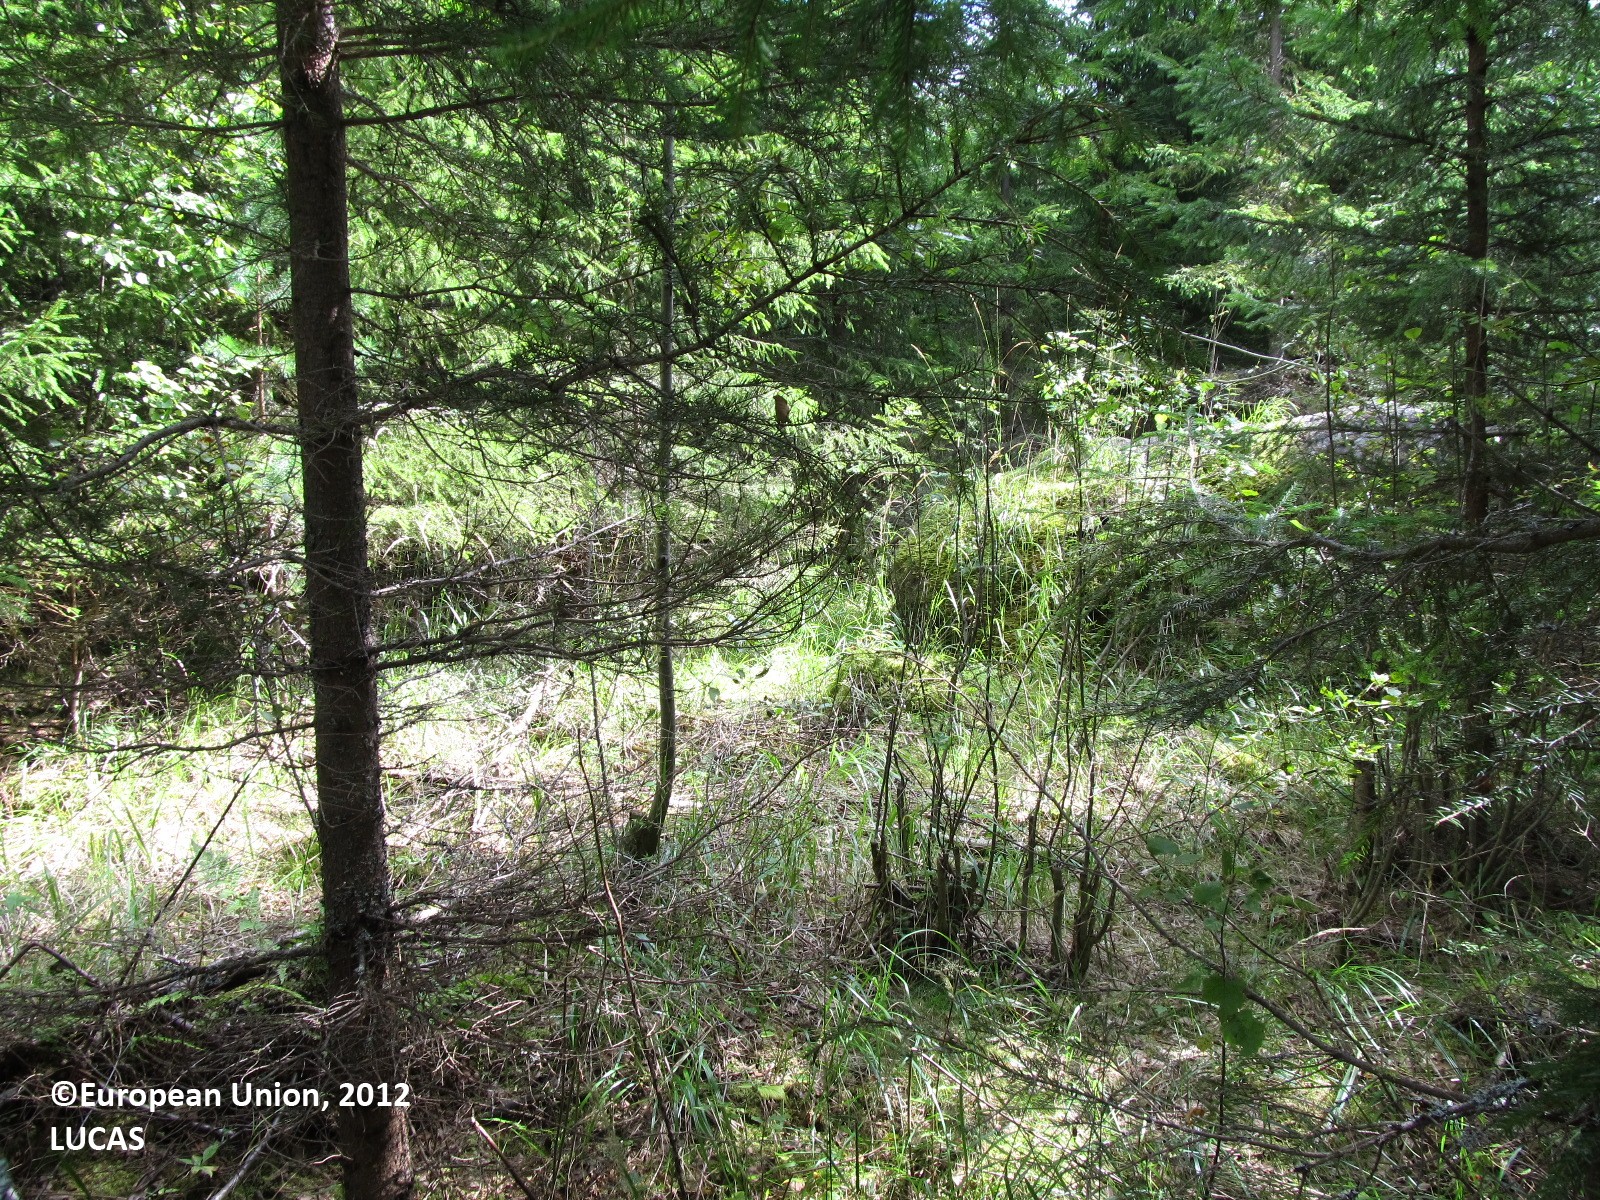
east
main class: Woodland
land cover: Spruce dominated coniferous woodland
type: boreal forest
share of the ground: 50 - 75 %
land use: Forestry
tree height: > 5 m
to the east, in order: Spruce dominated coniferous woodland; Spruce dominated mixed woodland; Pine dominated coniferous woodland; Electric lines; Ditches and canals; Grass margins; Paved roads, cycling and walking lanes; Grass margins; Ditches and canals; Electric lines; Broadleaved woodland; Artificial constructions in urban areas
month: August
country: FI
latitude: 62.2183
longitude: 28.4534
